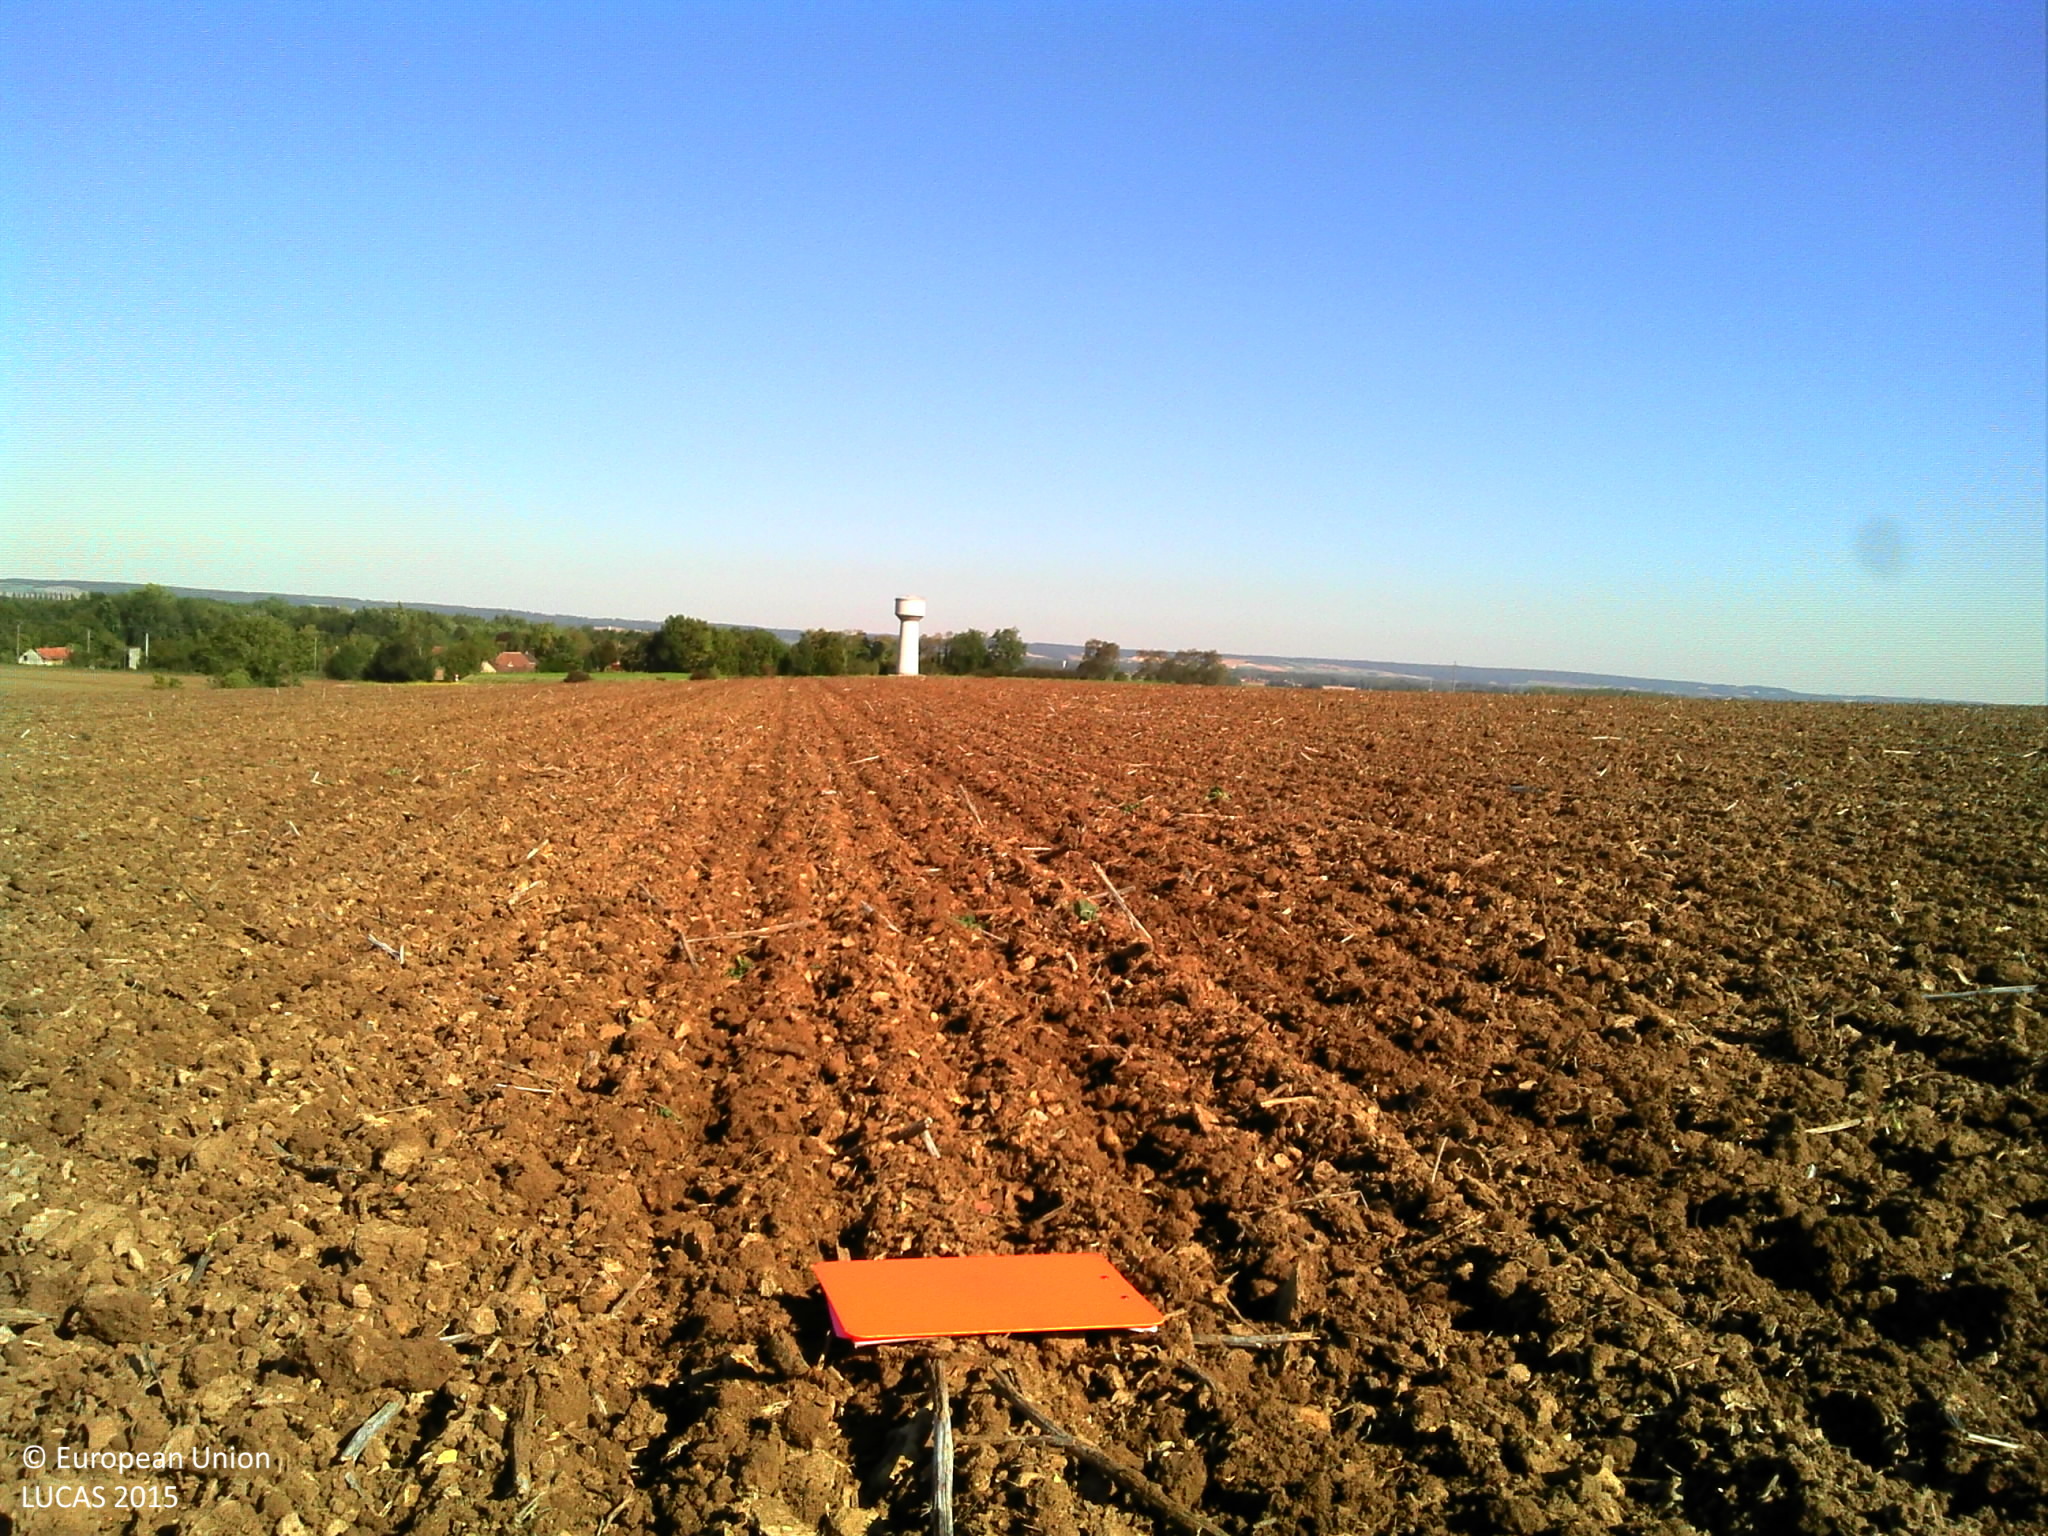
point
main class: Cropland
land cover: Rape and turnip rape
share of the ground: < 10 %
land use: Agriculture (excluding fallow land and kitchen gardens)
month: September
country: FR
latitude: 48.4025
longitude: 3.3613
